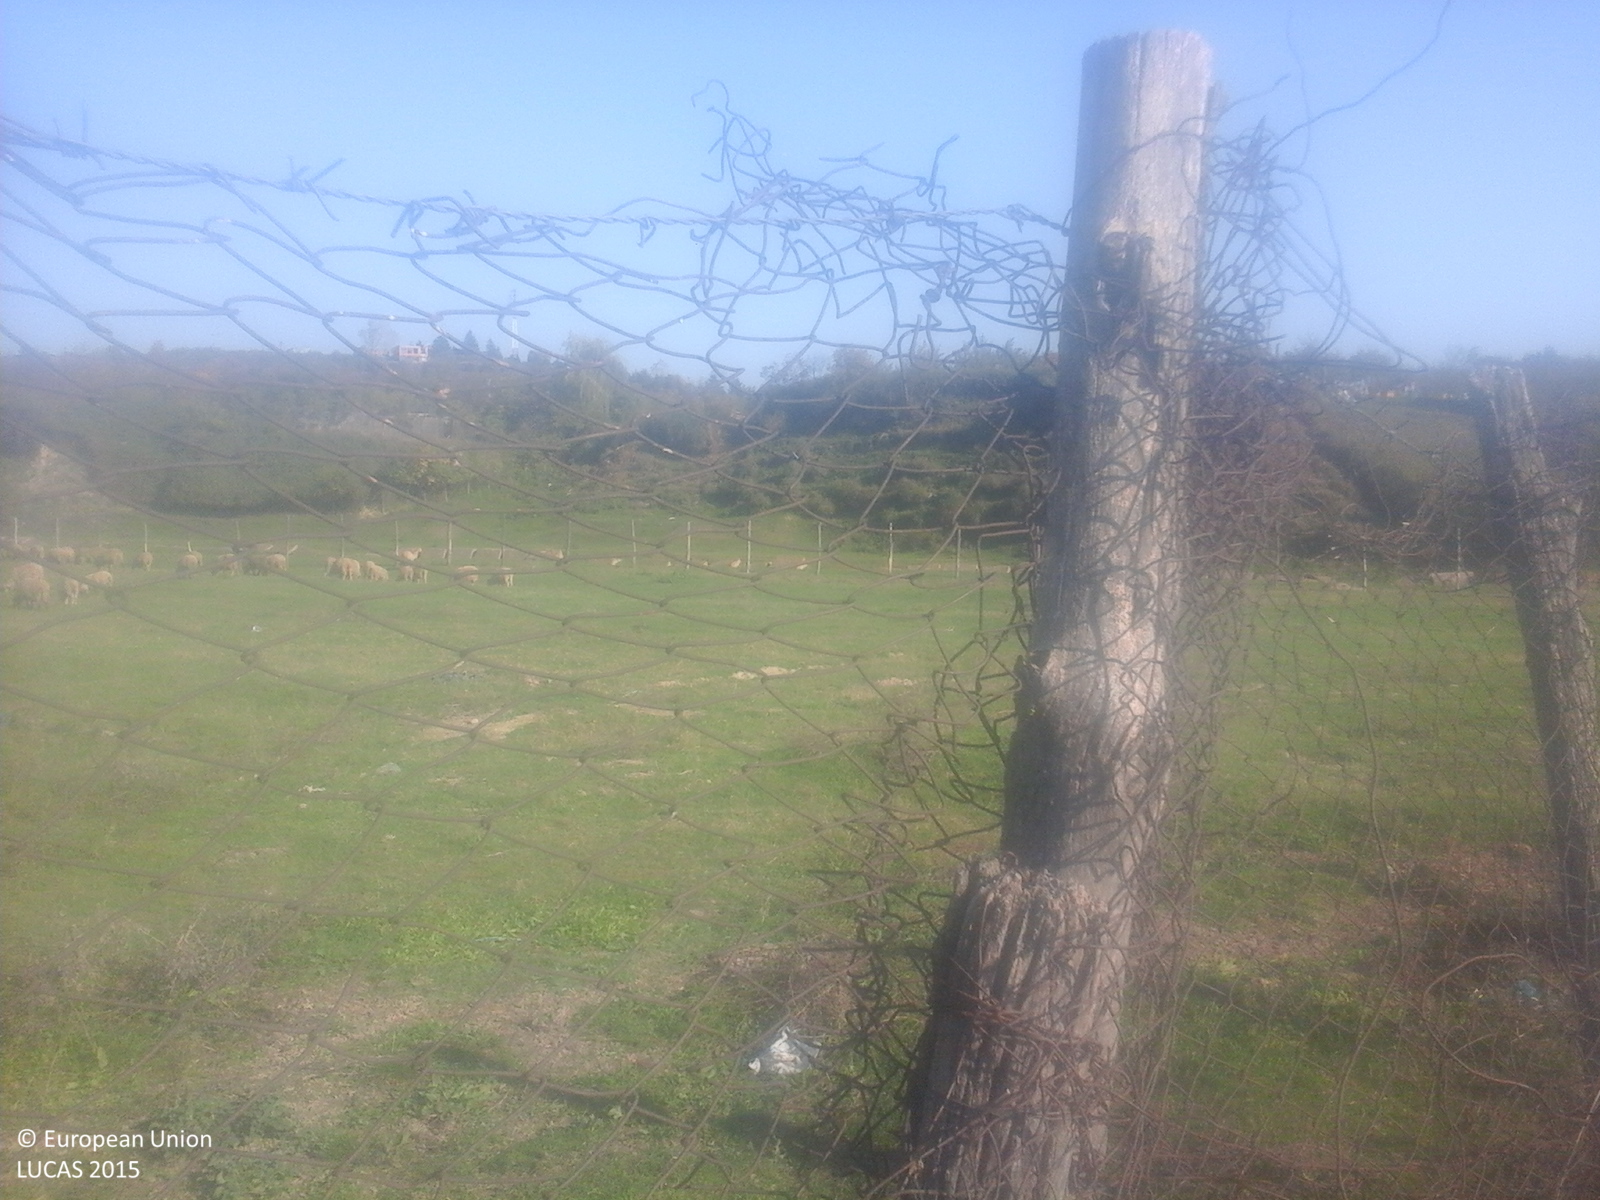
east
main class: Grassland
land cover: Grassland without tree/shrub cover
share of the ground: > 75 %
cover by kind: herbaceous plants 100 %
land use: Agriculture (excluding fallow land and kitchen gardens)
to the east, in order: Grassland without tree/shrub cover; Fences; Grassland without tree/shrub cover; Inland fresh running water; Grassland without tree/shrub cover; Dry stone walls; Grassland without tree/shrub cover; Artificial constructions in urban areas
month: October
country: RO
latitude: 45.2921
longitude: 26.8754
